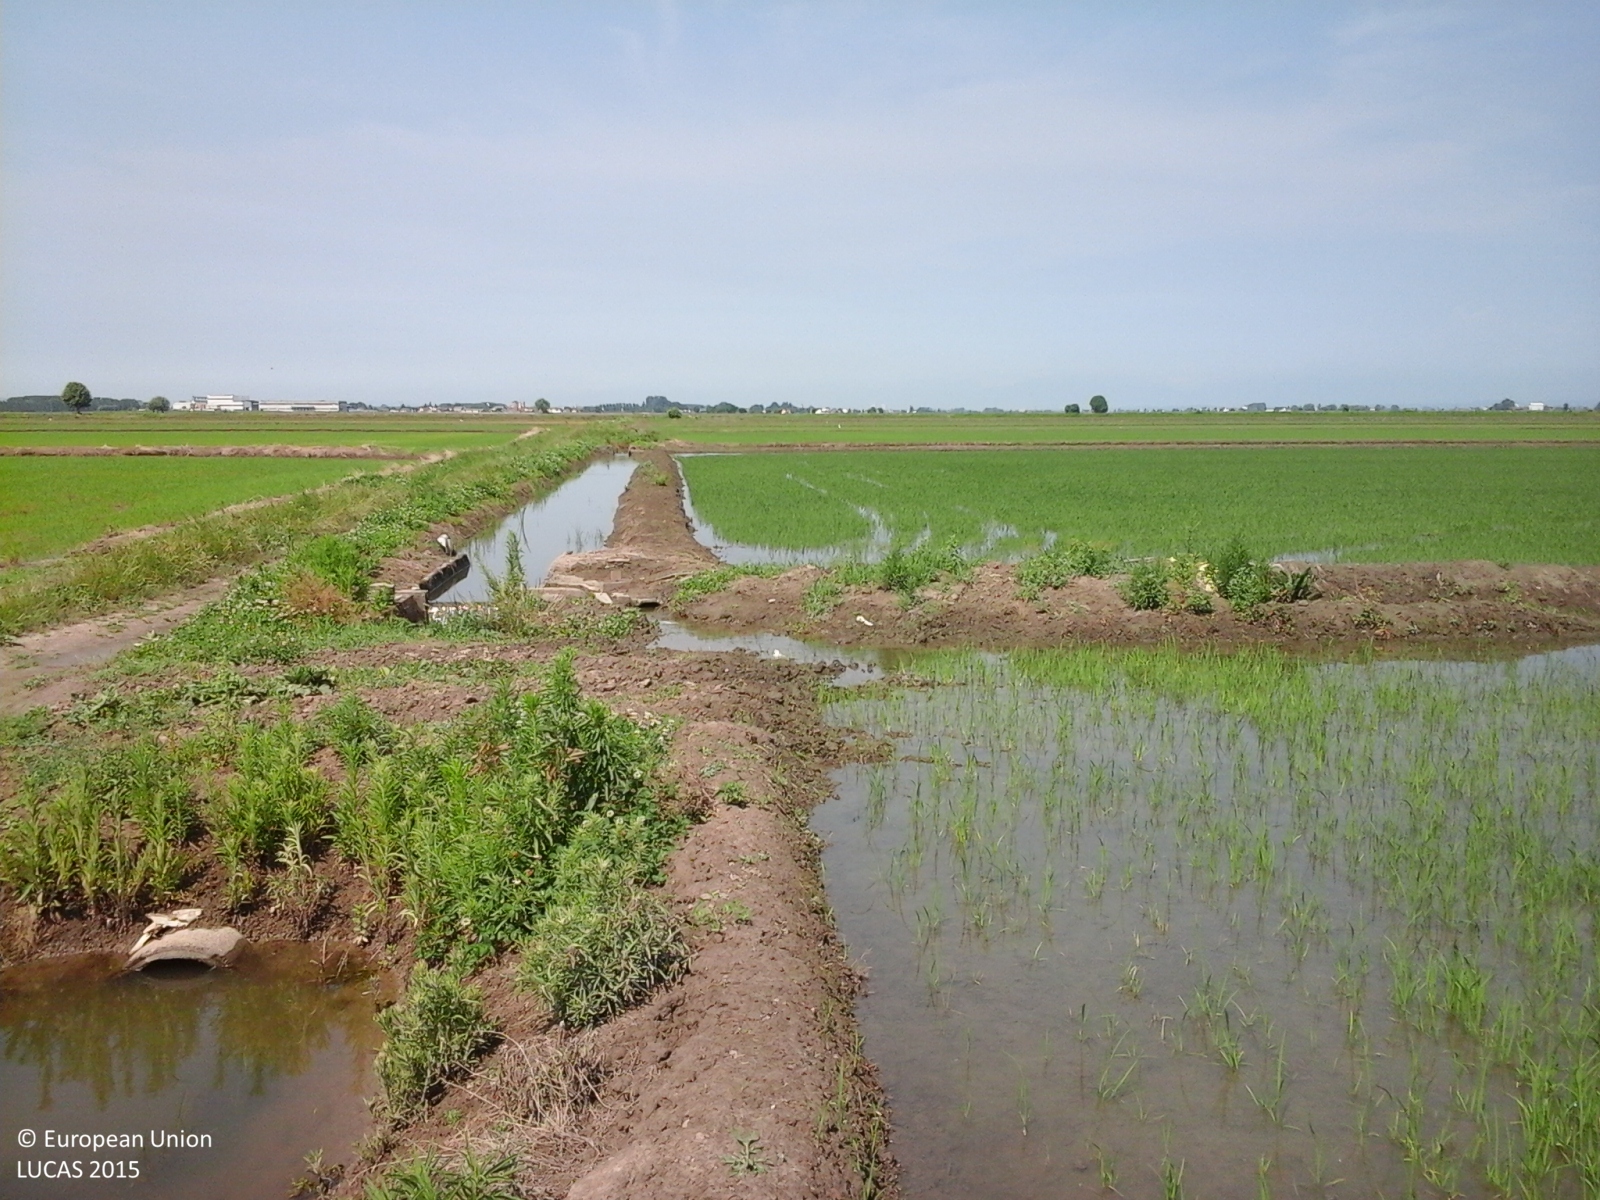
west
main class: Cropland
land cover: Rice
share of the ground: 25 - 50 %
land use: Agriculture (excluding fallow land and kitchen gardens)
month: July
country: IT
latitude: 45.2401
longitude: 8.4104
